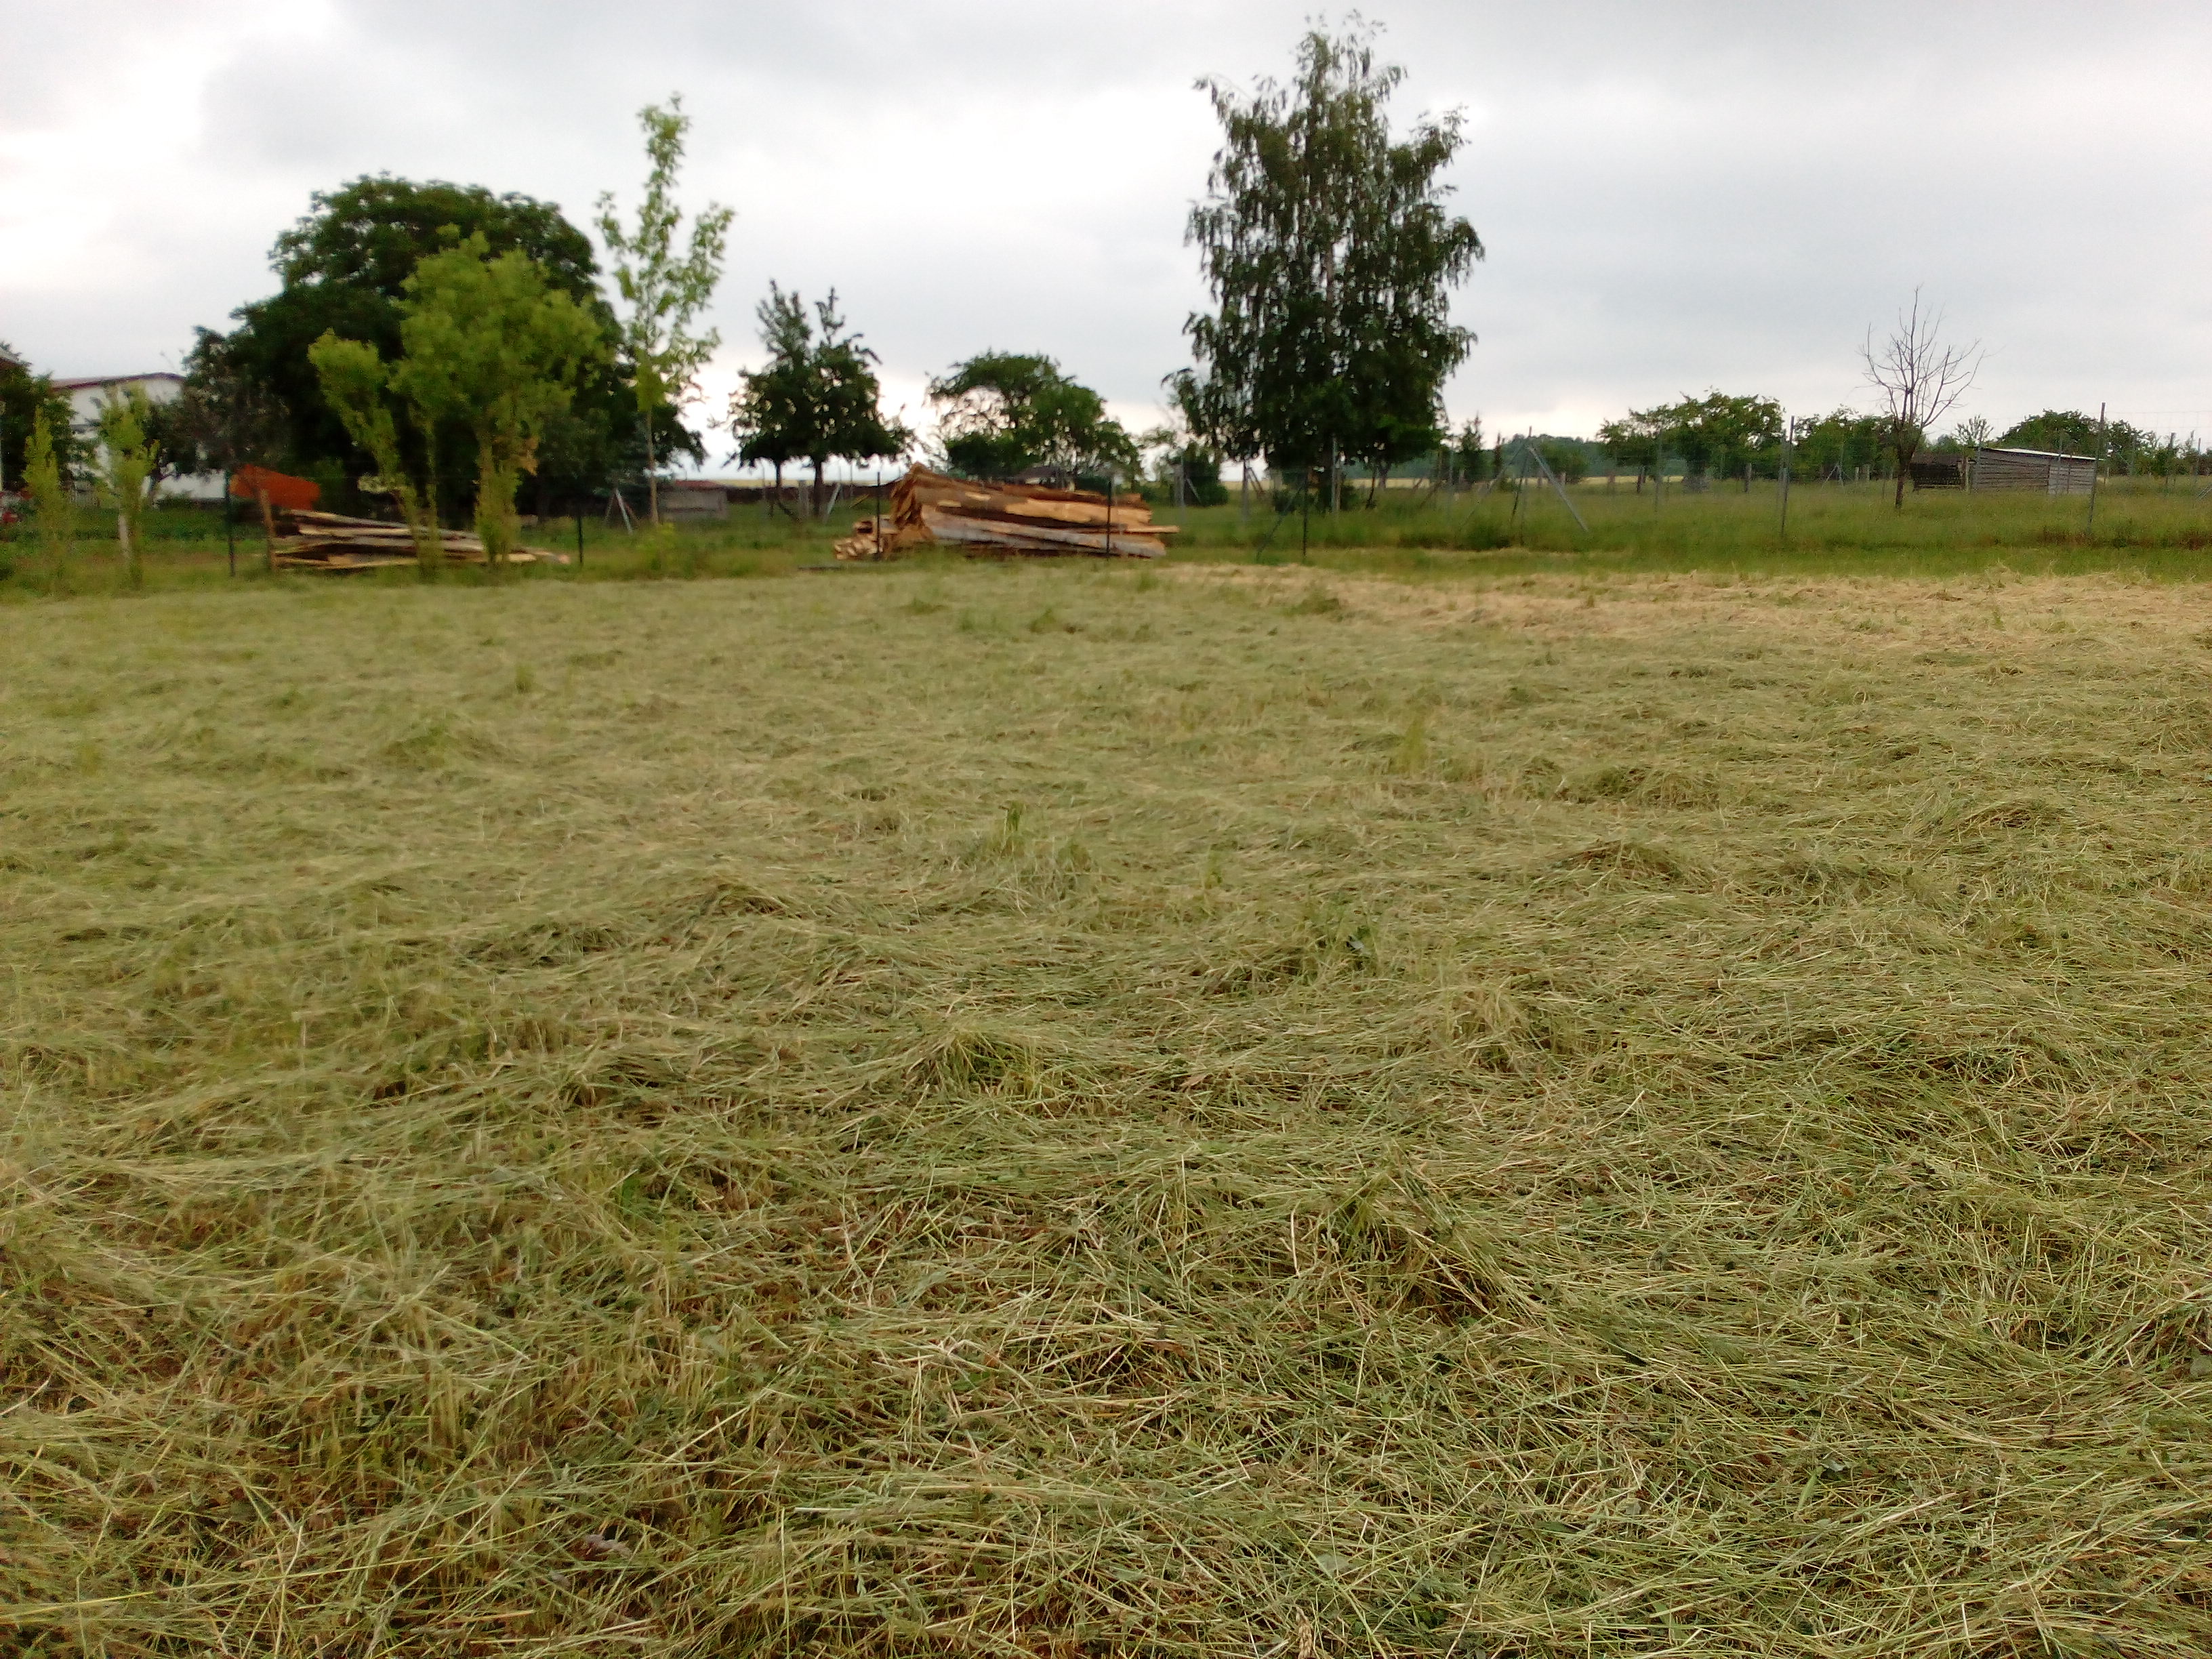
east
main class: Grassland
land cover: Grassland without tree/shrub cover
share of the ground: > 75 %
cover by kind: herbaceous plants 100 %
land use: Agriculture (excluding fallow land and kitchen gardens)
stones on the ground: < 10 %
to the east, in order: Grassland without tree/shrub cover; Lines of trees; Grass margins; Artificial constructions in urban areas; Grassland without tree/shrub cover; Barley; Grassland without tree/shrub cover; Barley
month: June
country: DE
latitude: 51.0636
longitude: 10.6134
